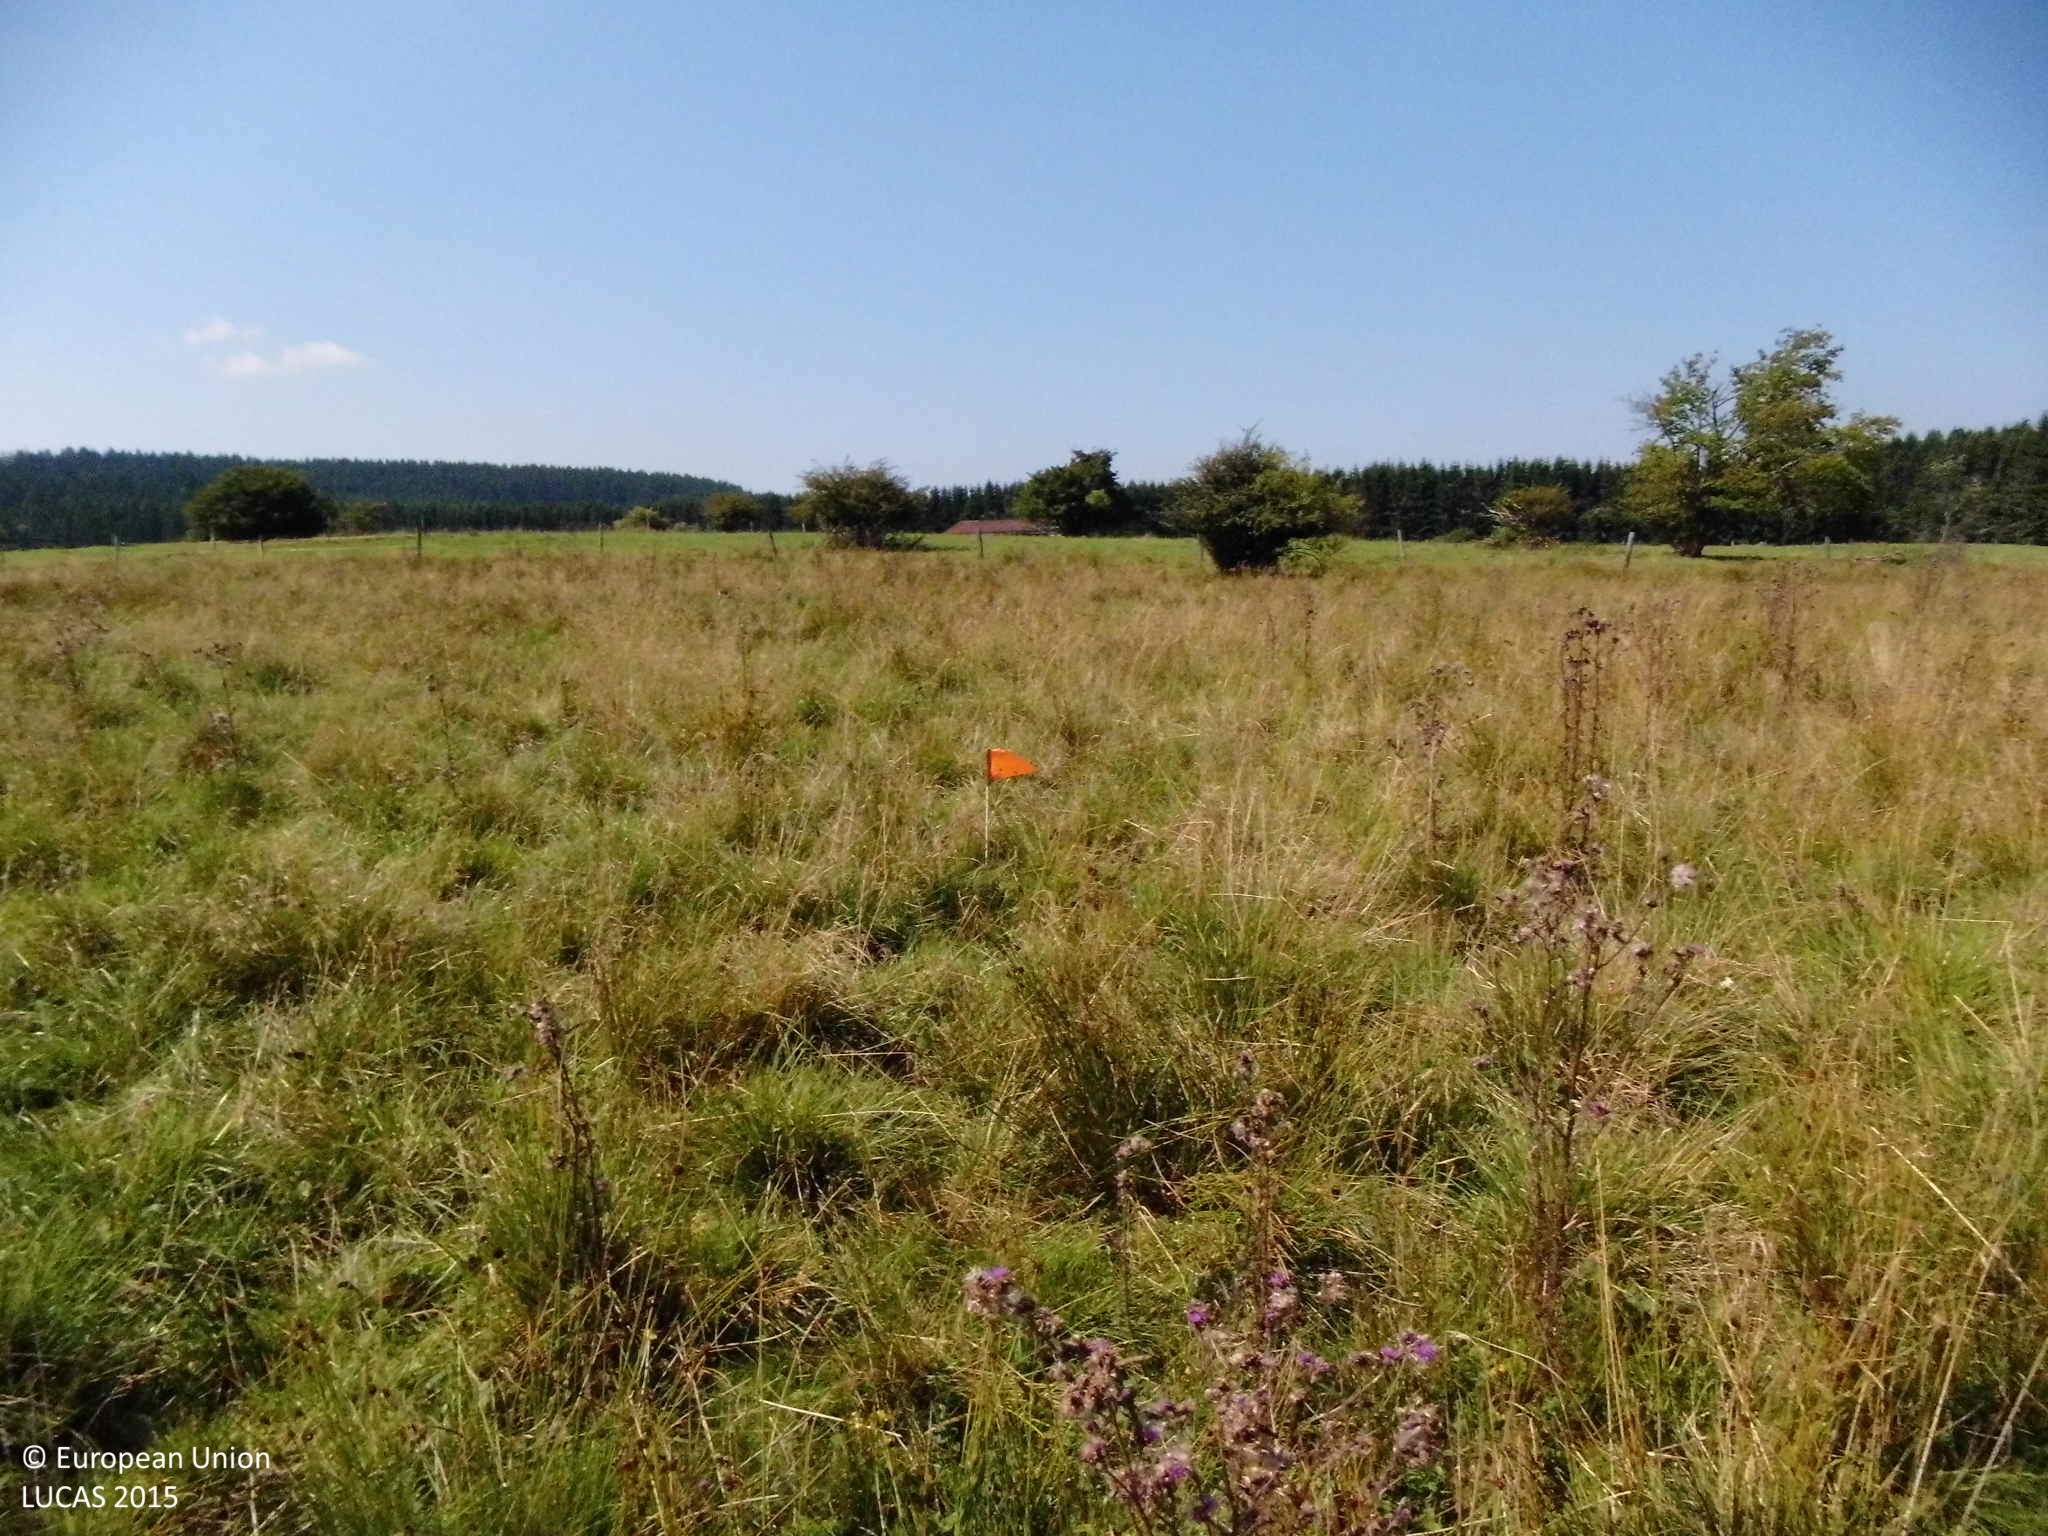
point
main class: Grassland
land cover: Spontaneously vegetated surfaces
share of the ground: > 75 %
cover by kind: herbaceous plants 95 %, shrubs 5 %
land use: Fallow land
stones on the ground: < 10 %
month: August
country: DE
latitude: 50.6723
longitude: 8.1184
